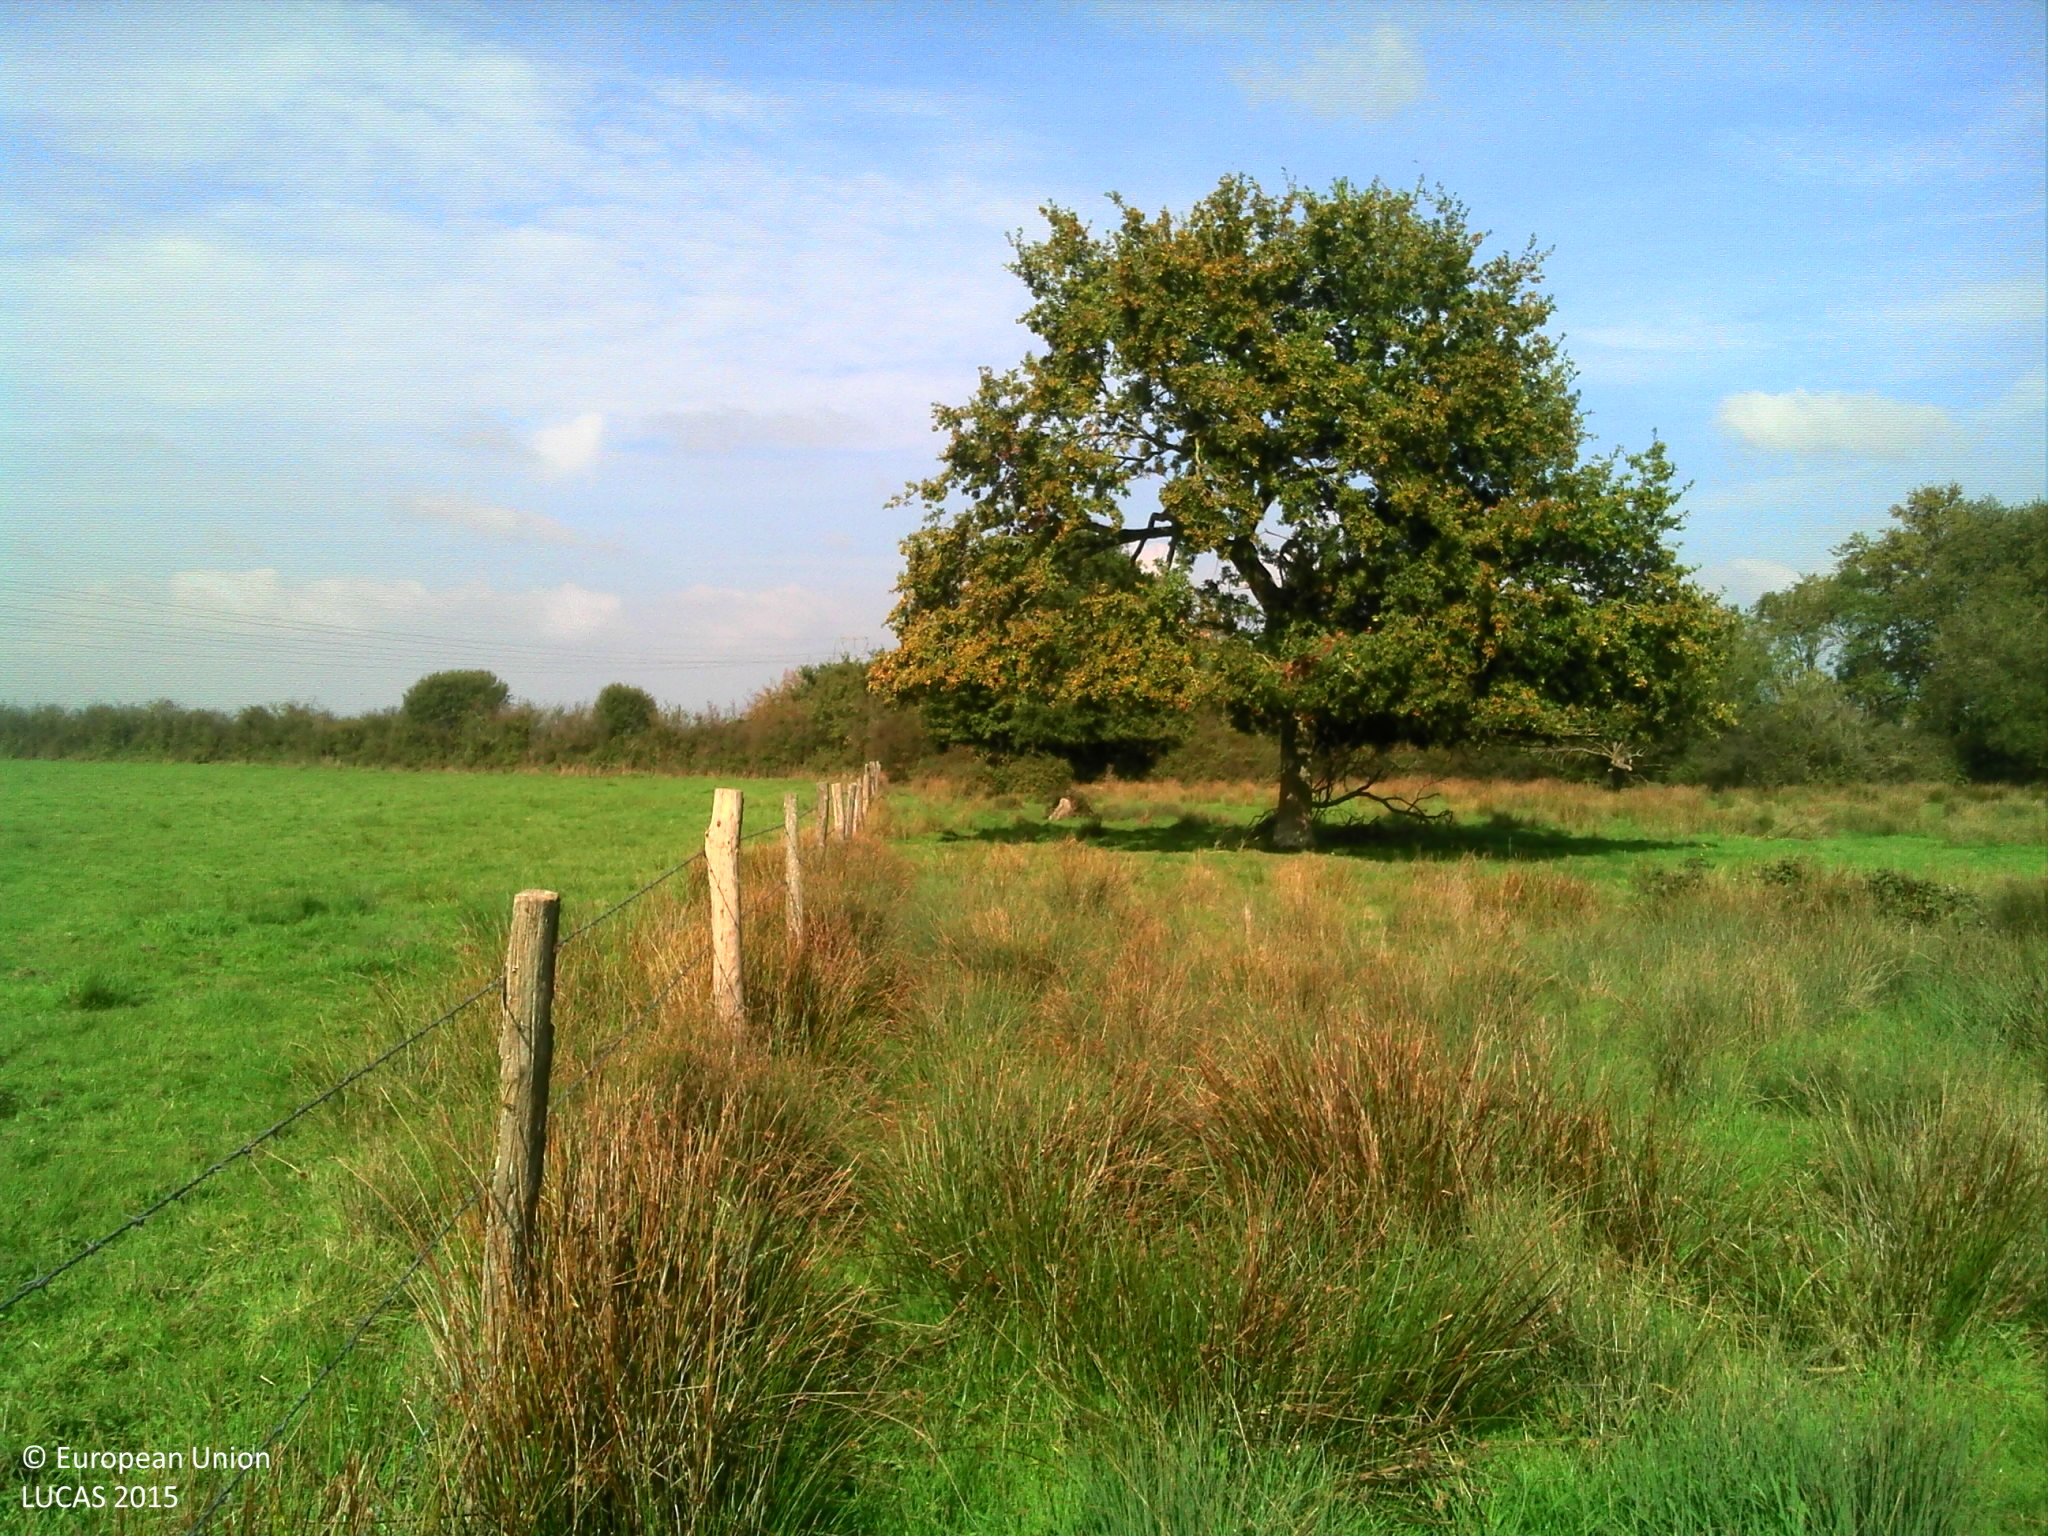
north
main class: Grassland
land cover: Grassland without tree/shrub cover
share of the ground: > 75 %
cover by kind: herbaceous plants 100 %
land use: Agriculture (excluding fallow land and kitchen gardens)
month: October
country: FR
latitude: 47.0973
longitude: -0.9297
